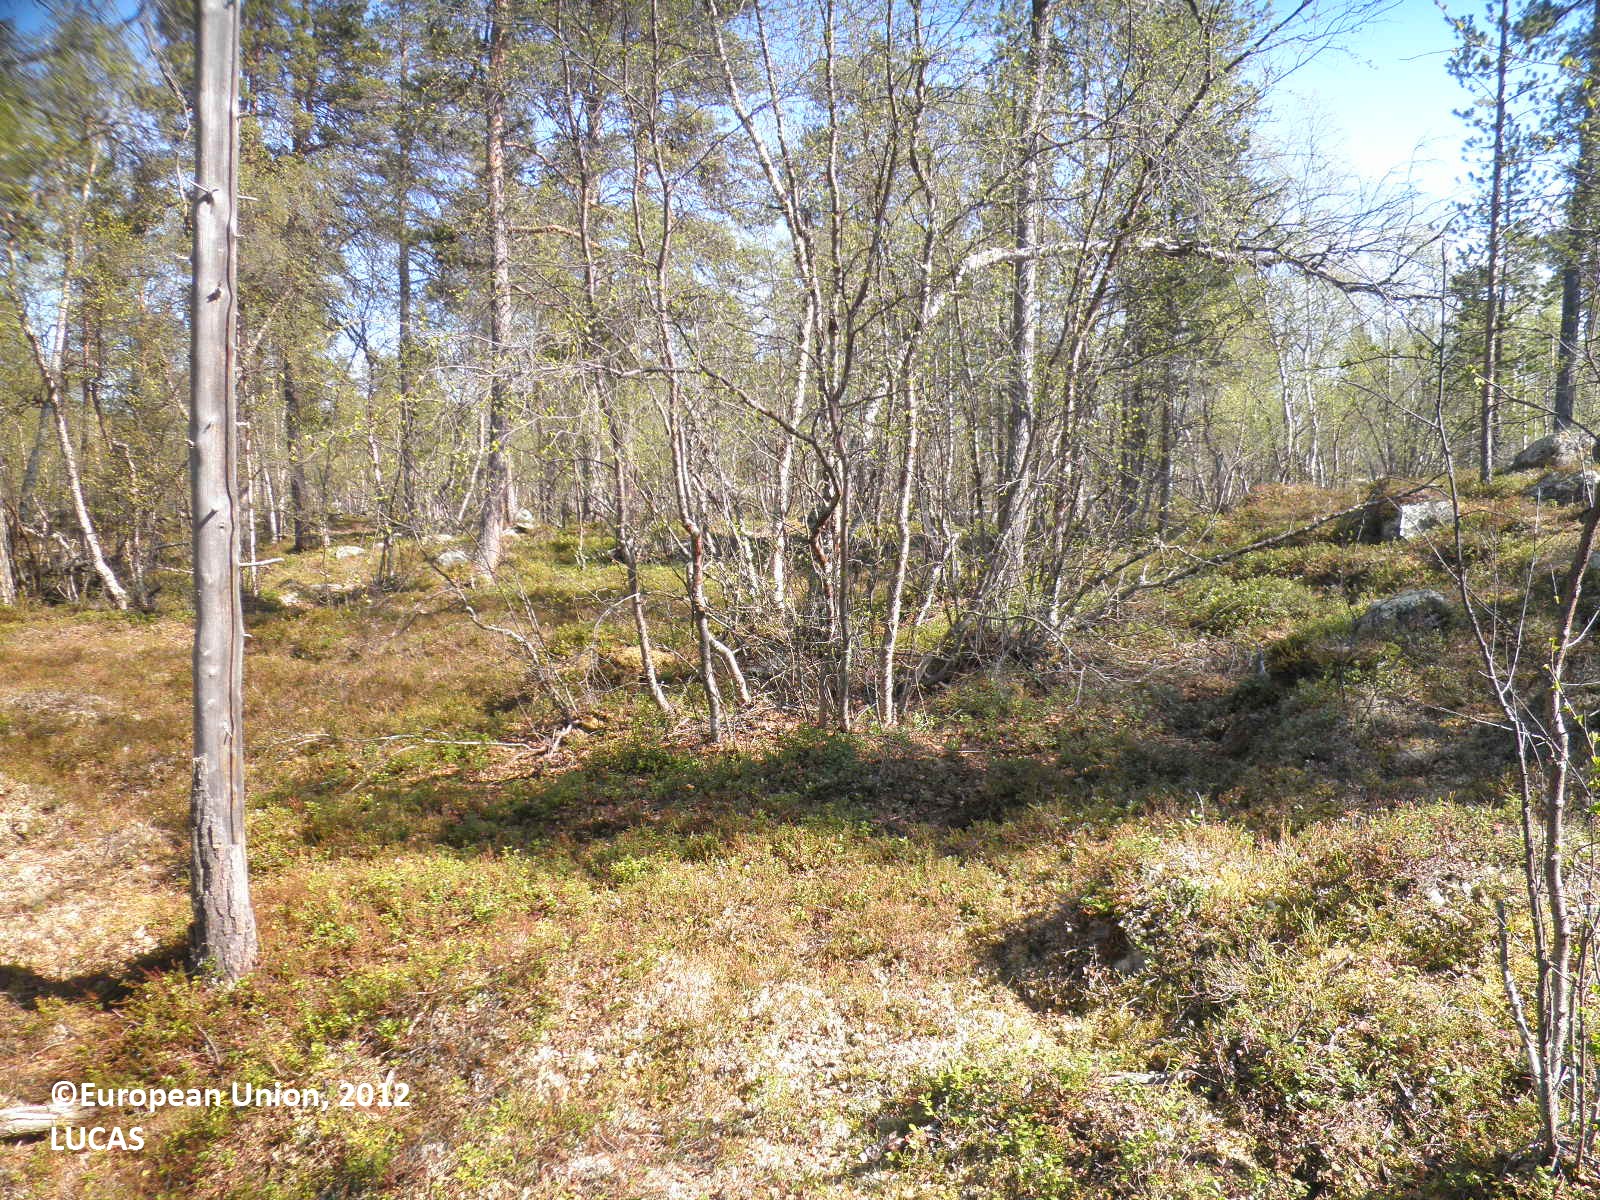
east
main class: Woodland
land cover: Pine dominated mixed woodland
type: boreal forest
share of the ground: > 75 %
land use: Forestry
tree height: > 5 m
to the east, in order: Pine dominated mixed woodland
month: June
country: FI
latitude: 69.4923
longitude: 28.5849
